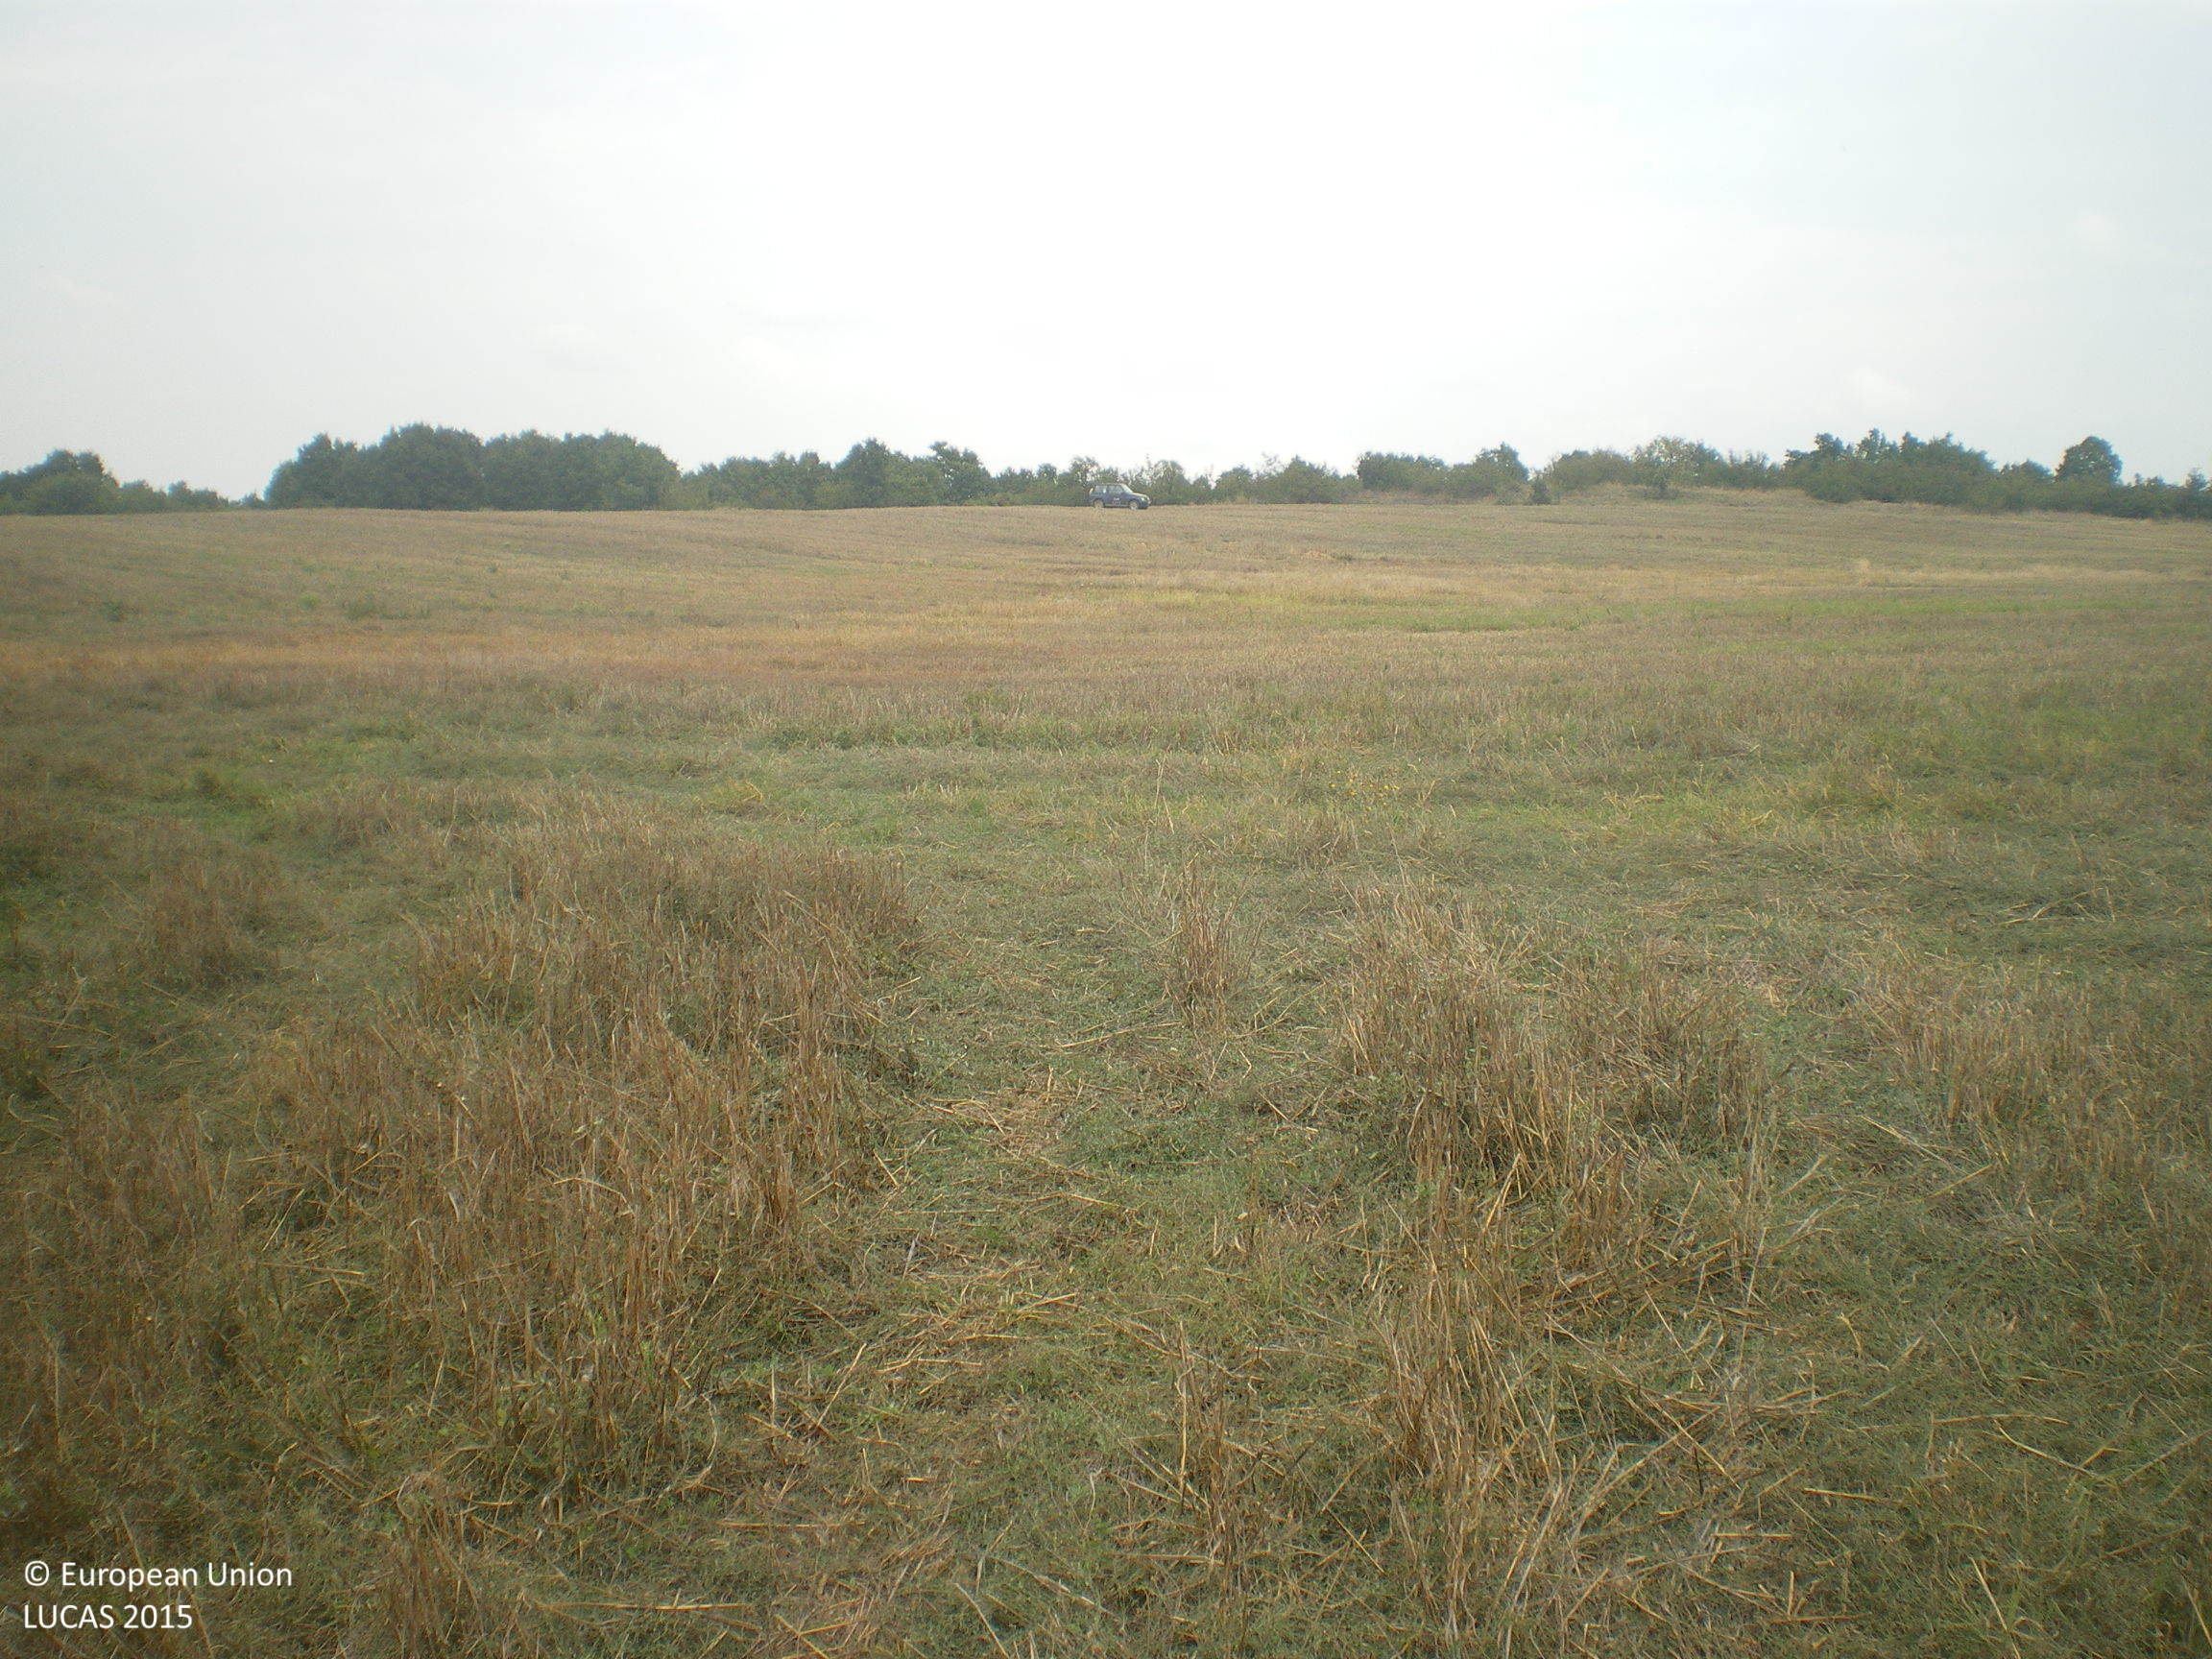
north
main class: Cropland
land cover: Common wheat
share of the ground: 10 - 25 %
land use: Agriculture (excluding fallow land and kitchen gardens)
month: September
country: BG
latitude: 42.0404
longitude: 25.9599
